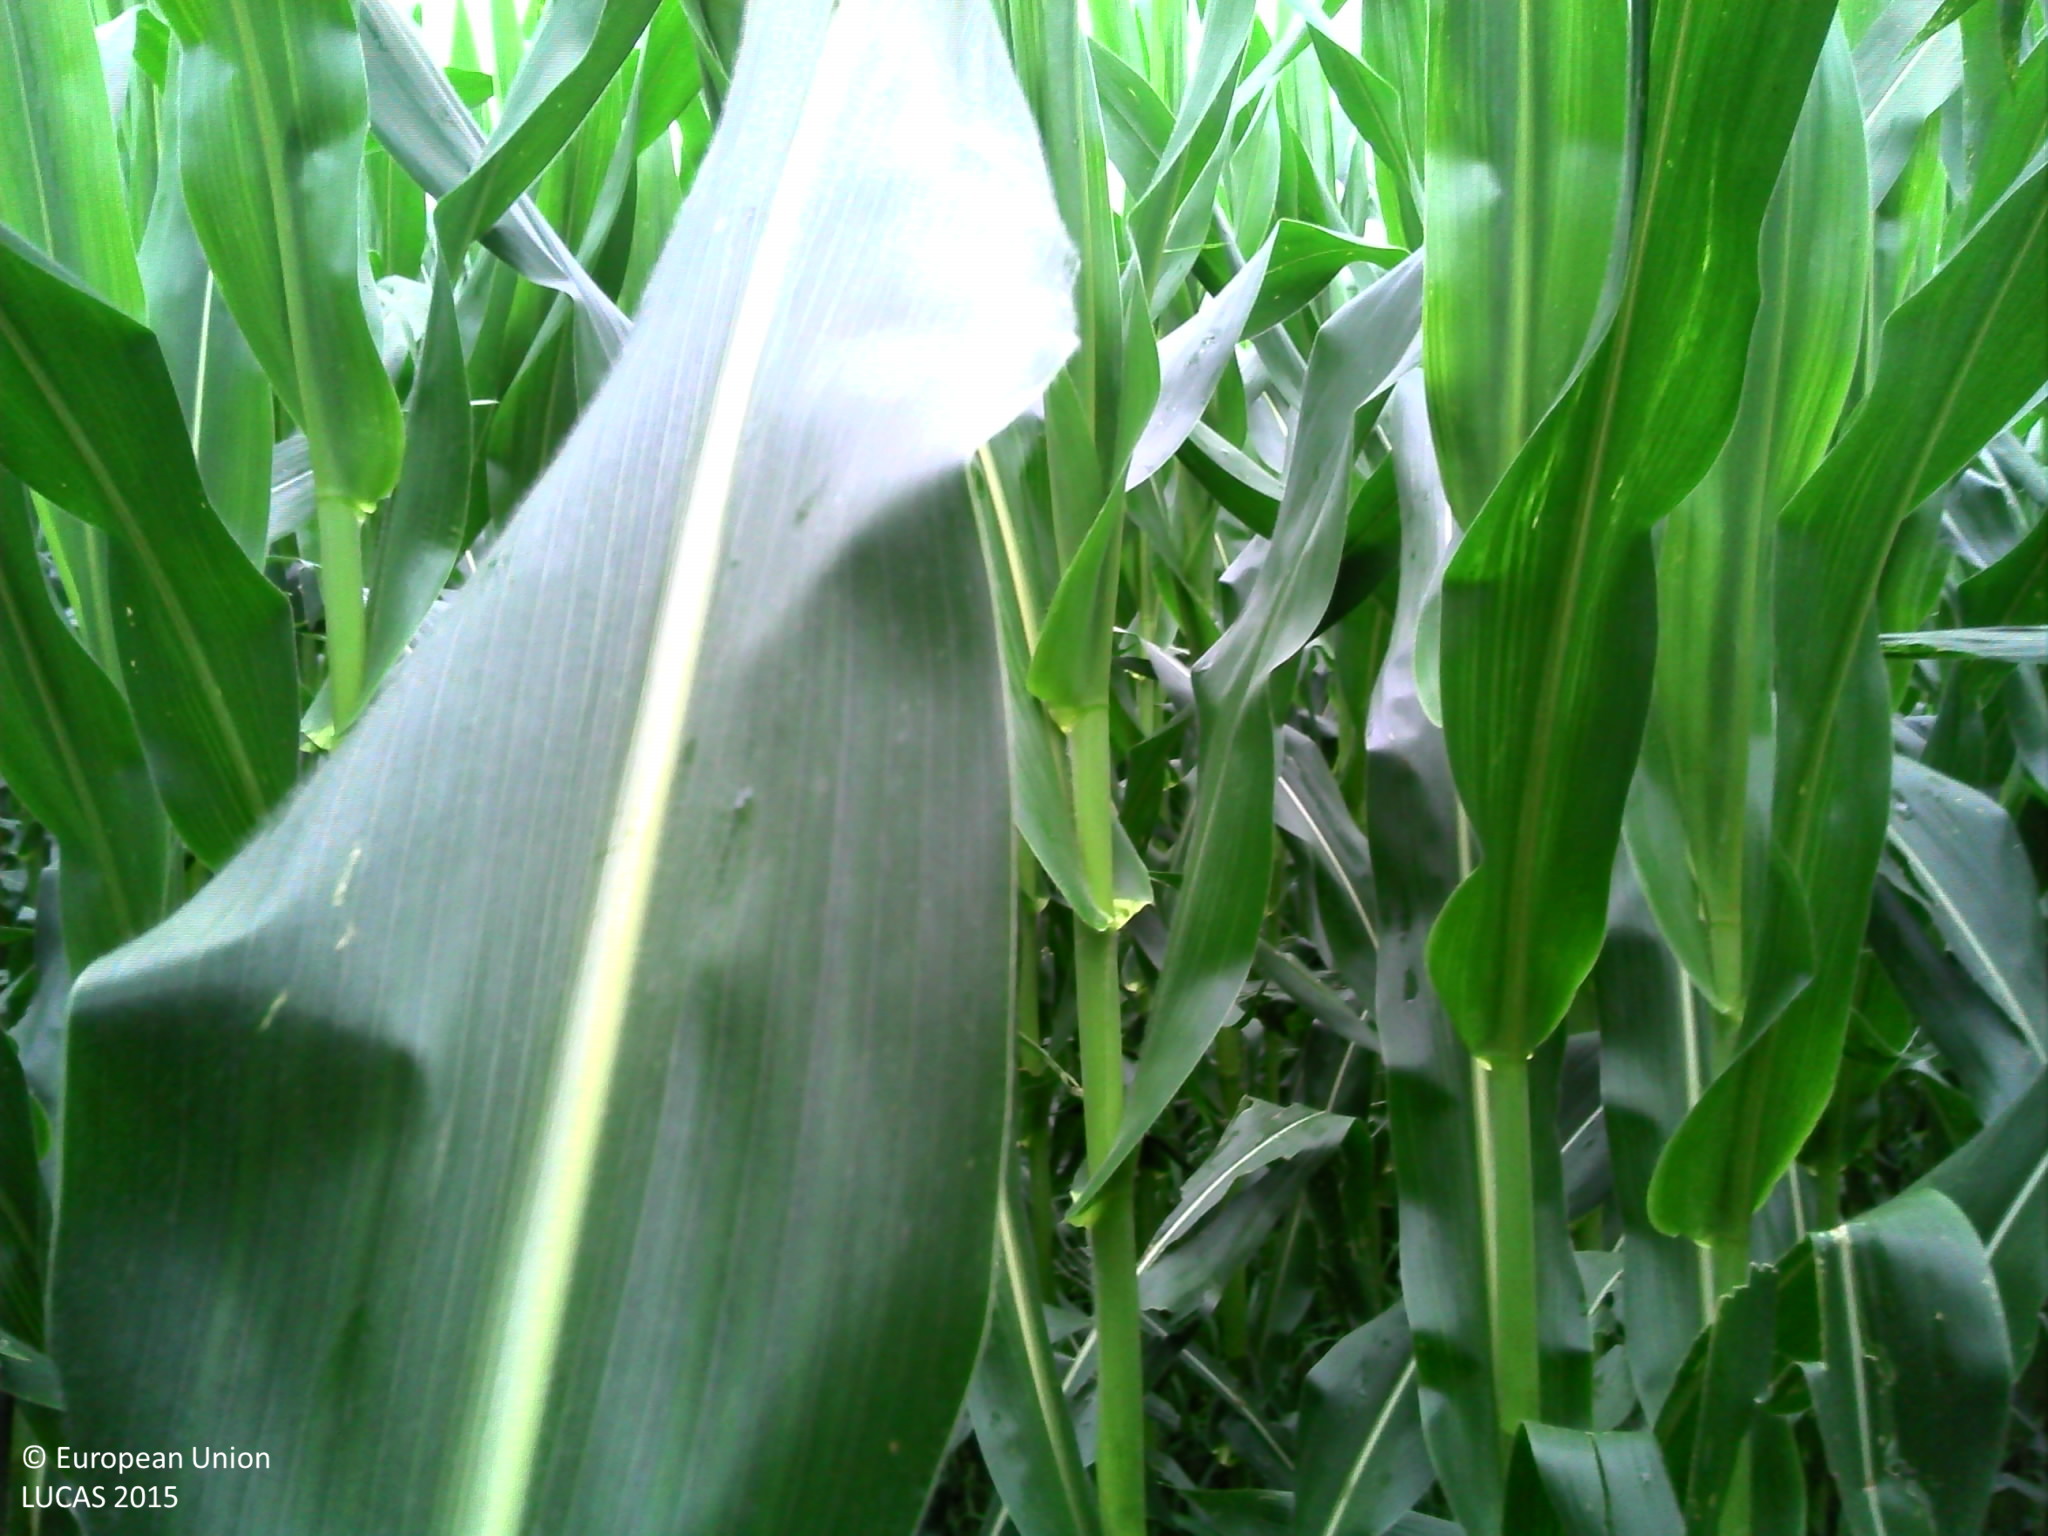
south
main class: Cropland
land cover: Maize
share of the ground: > 75 %
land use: Agriculture (excluding fallow land and kitchen gardens)
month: August
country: FR
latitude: 43.4307
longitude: -1.2197
